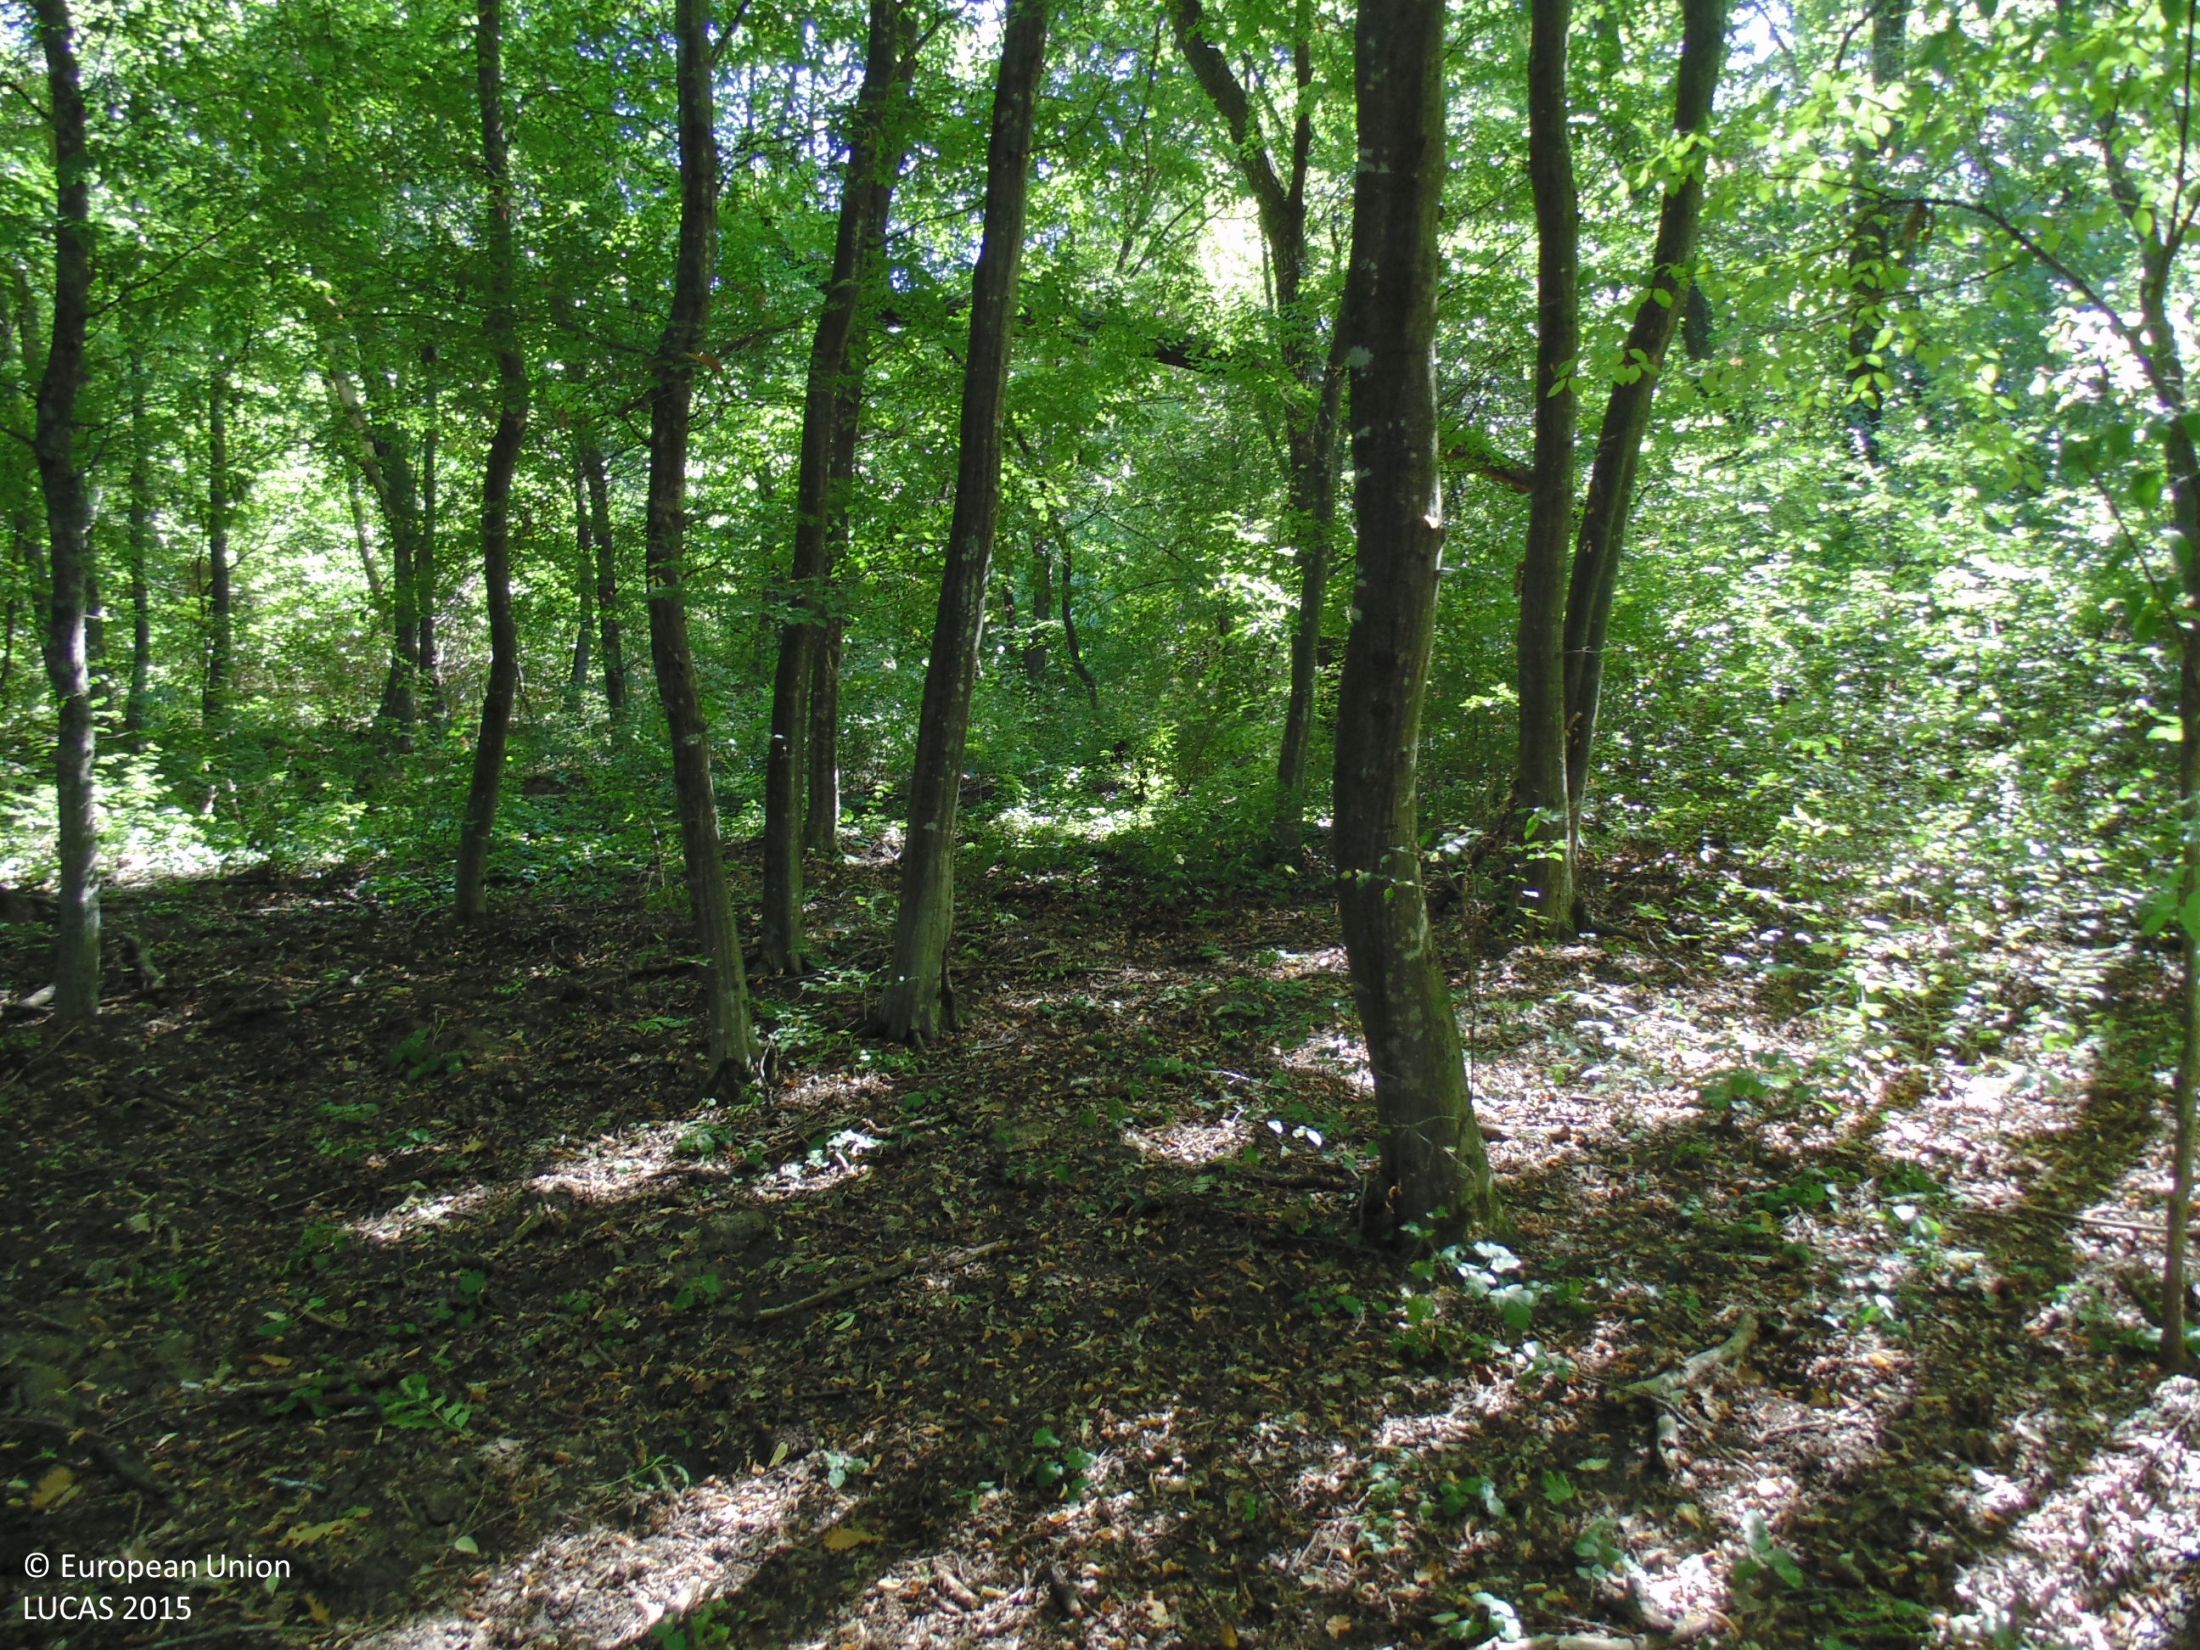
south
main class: Woodland
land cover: Broadleaved woodland
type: mesophytic deciduous forest
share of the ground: > 75 %
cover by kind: broadleaved forest trees 95 %, unconsolidated bare surface 5 %
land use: Forestry
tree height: > 5 m
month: September
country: BG
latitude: 43.8682
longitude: 27.0332
